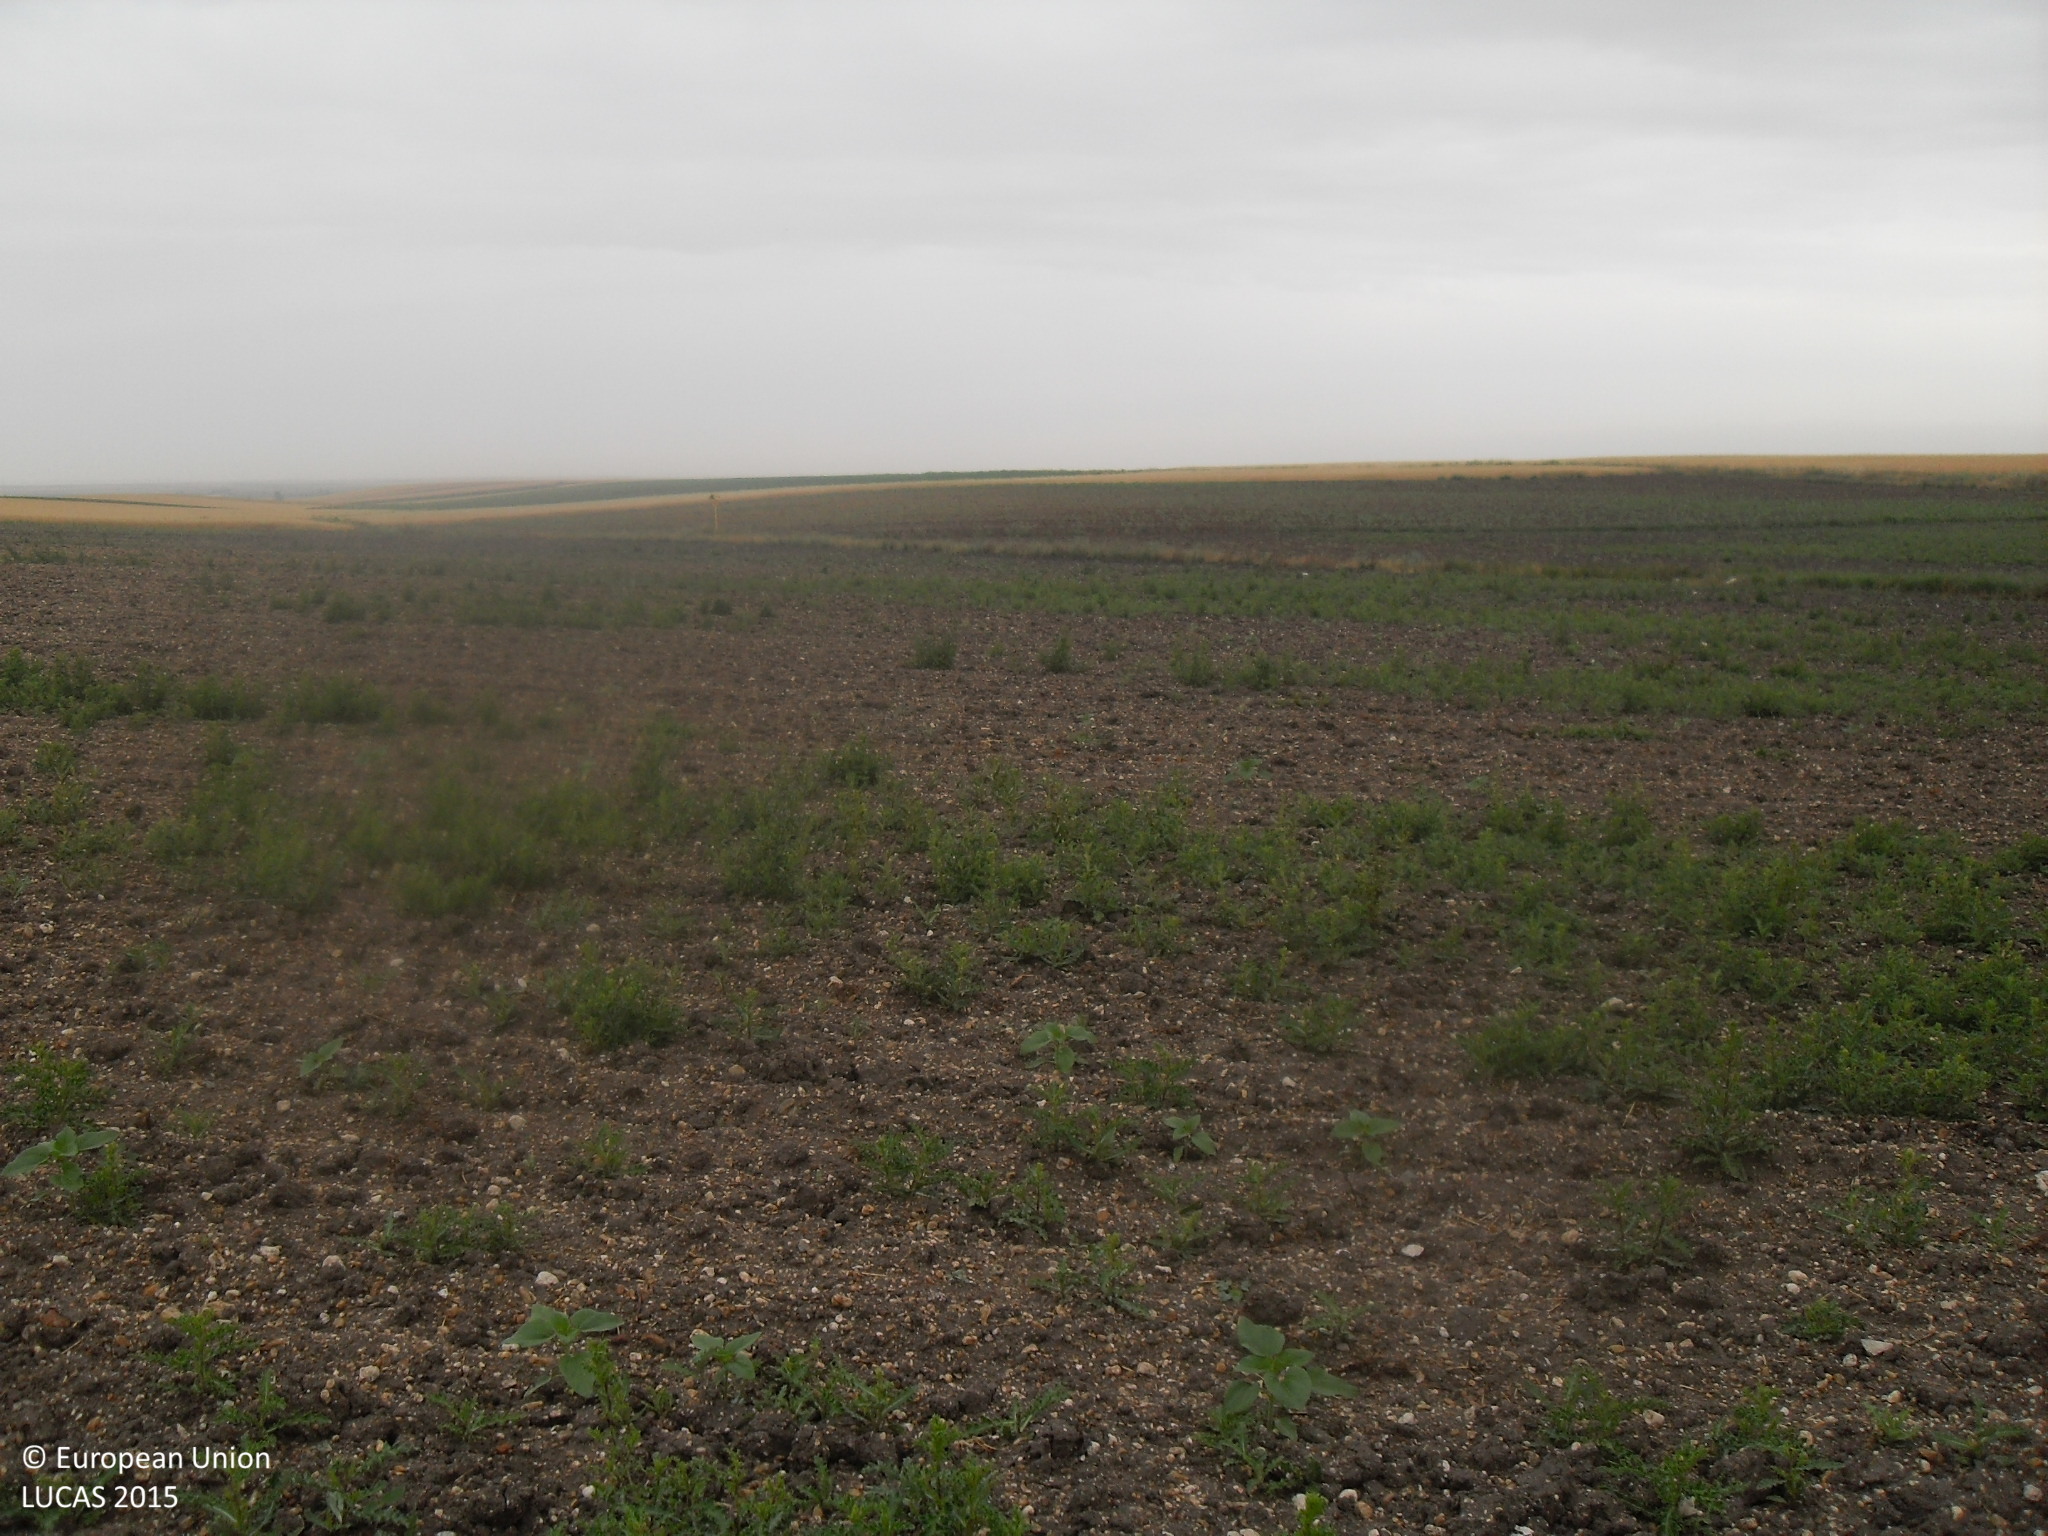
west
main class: Cropland
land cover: Barley
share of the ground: > 75 %
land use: Agriculture (excluding fallow land and kitchen gardens)
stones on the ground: < 10 %
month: June
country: ES
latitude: 41.1061
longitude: -5.7149
